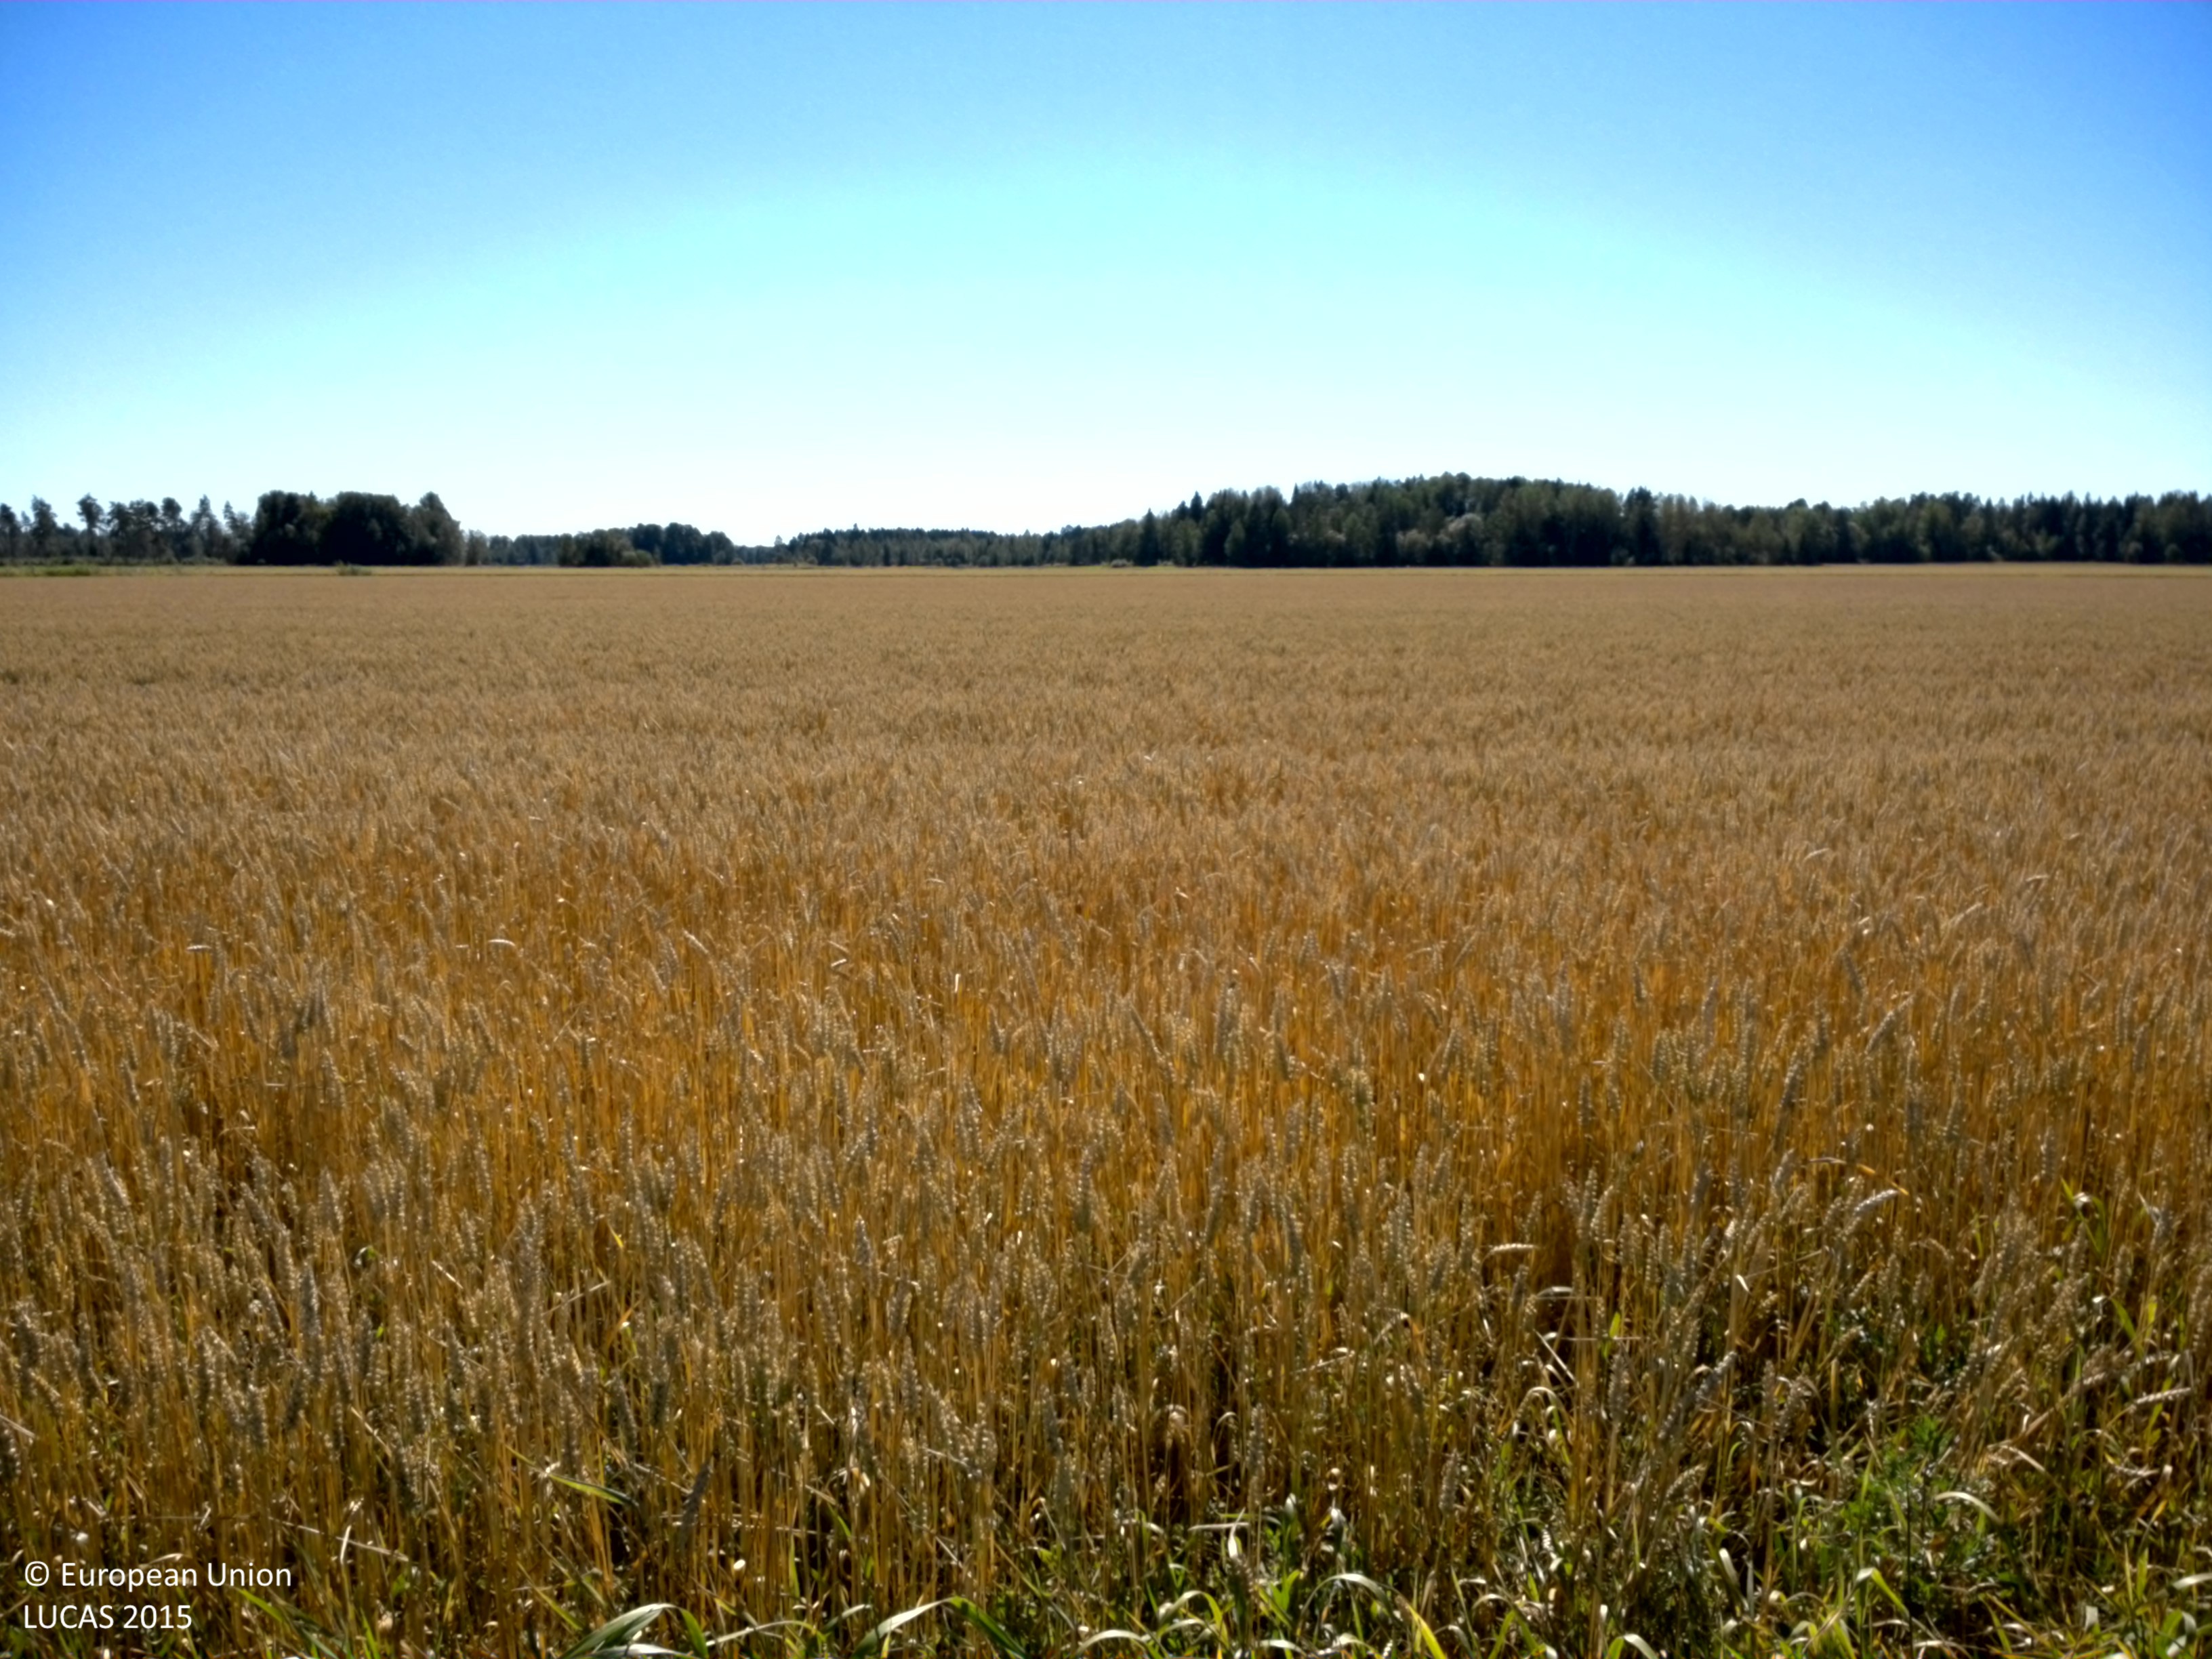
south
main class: Cropland
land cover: Common wheat
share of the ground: > 75 %
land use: Agriculture (excluding fallow land and kitchen gardens)
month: August
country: SE
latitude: 60.1301
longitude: 17.0657
